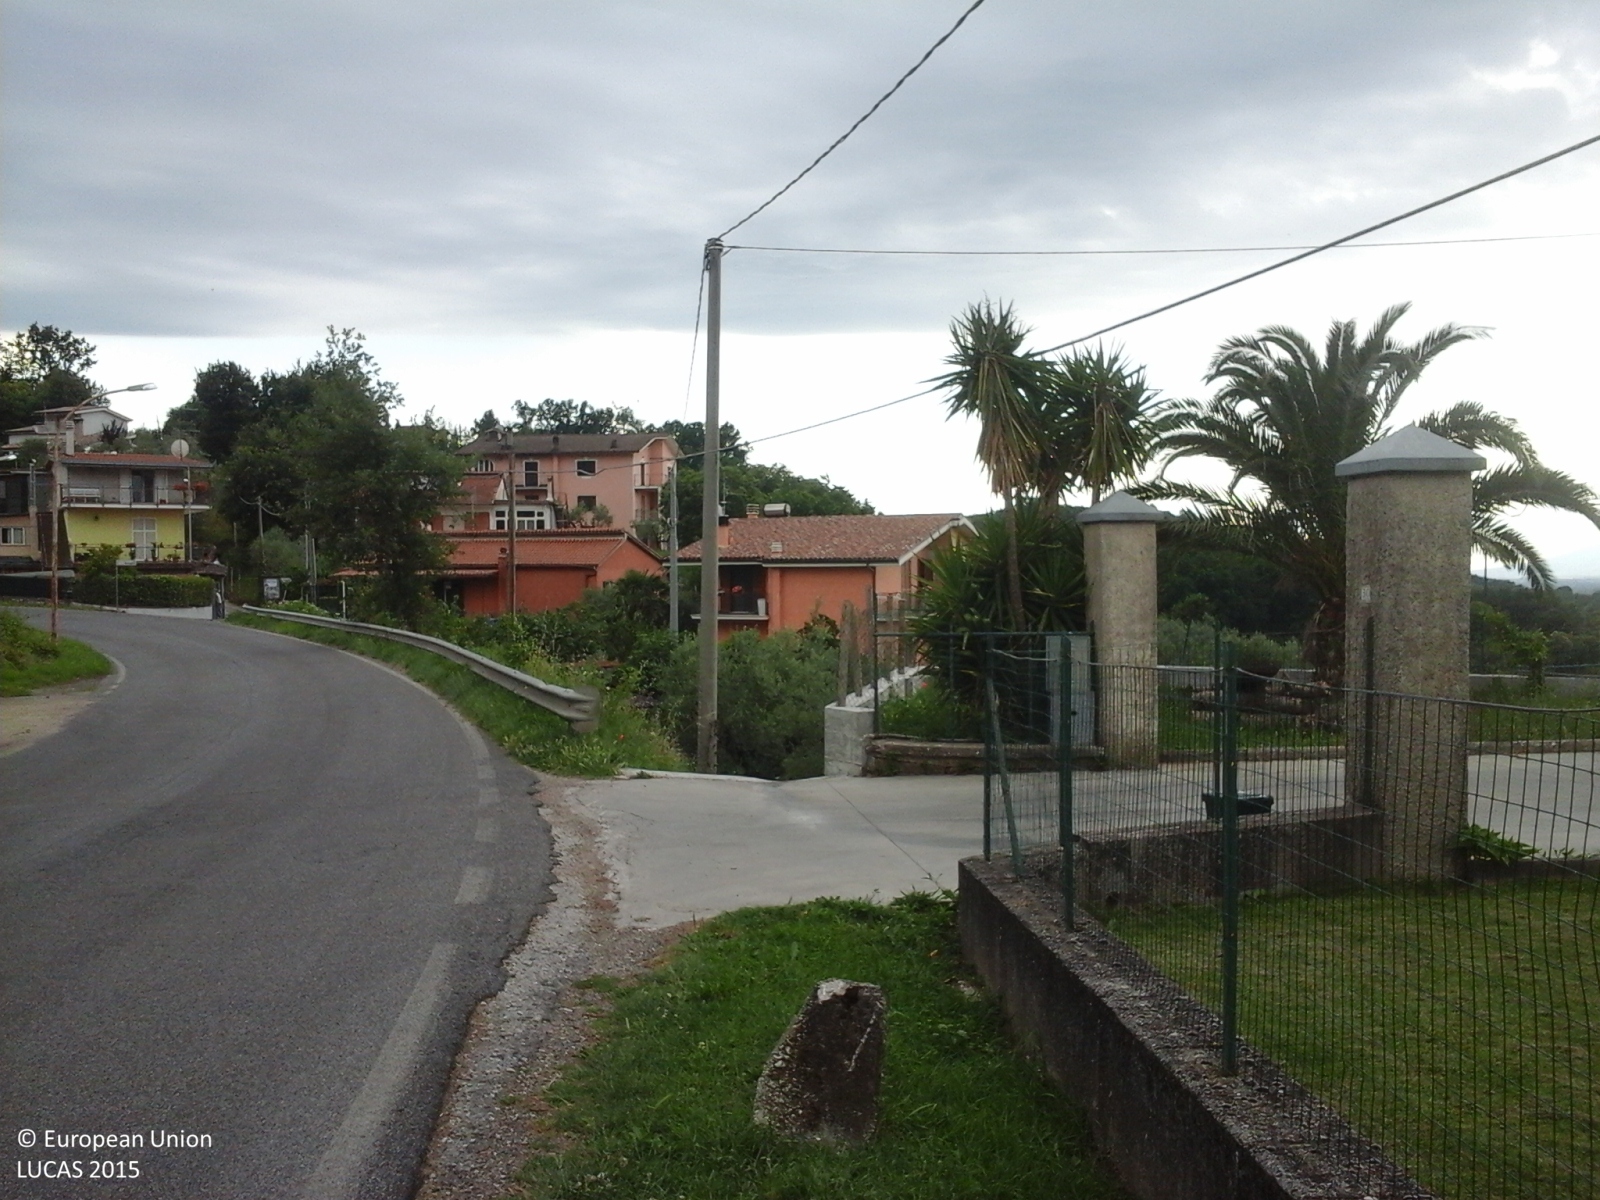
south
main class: Grassland
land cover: Grassland without tree/shrub cover
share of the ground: > 75 %
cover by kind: herbaceous plants 100 %
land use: Residential
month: June
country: IT
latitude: 41.8297
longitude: 13.0831
